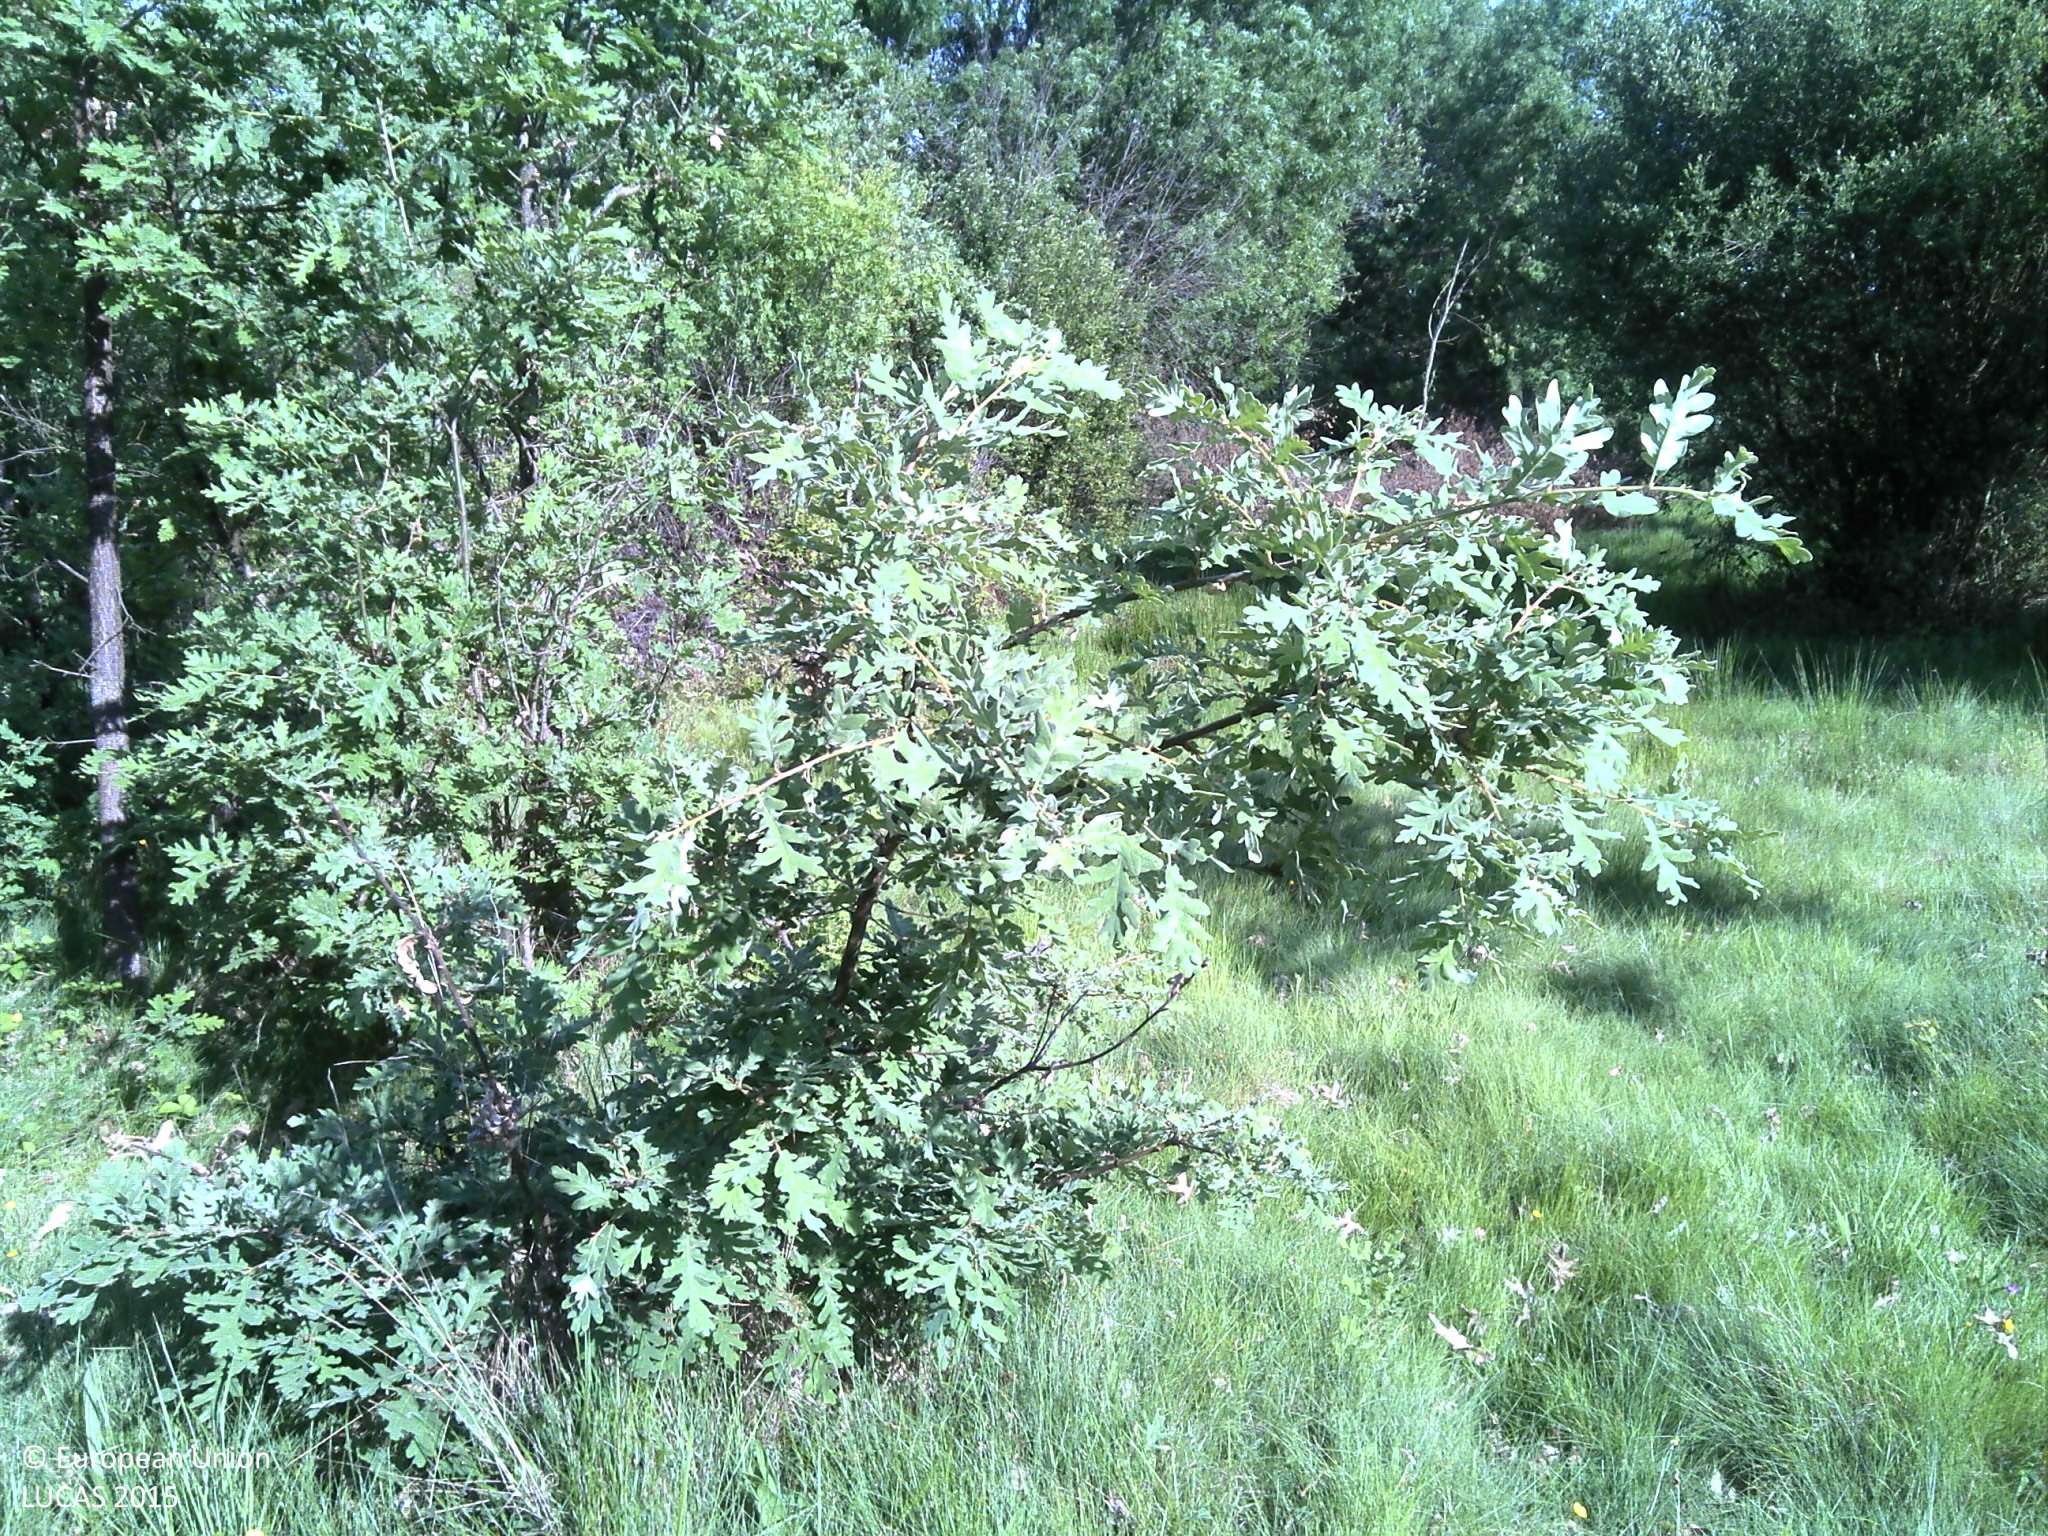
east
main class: Grassland
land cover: Grassland with sparse tree/shrub cover
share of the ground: > 75 %
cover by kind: herbaceous plants 95 %, broadleaved forest trees 5 %
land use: Agriculture (excluding fallow land and kitchen gardens)
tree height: > 5 m
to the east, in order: Grassland with sparse tree/shrub cover; Dry stone walls; Lines of trees; Grassland with sparse tree/shrub cover; Lines of trees; Dry stone walls; Grass margins; Tracks; Grass margins; Dry stone walls; Lines of trees; Grassland with sparse tree/shrub cover; Fences; Grassland without tree/shrub cover; Dry stone walls; Shrubland with sparse tree cover; Grassland without tree/shrub cover; Lines of trees; Dry stone walls; Grassland without tree/shrub cover; Lines of trees; Grassland without tree/shrub cover
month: May
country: PT
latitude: 41.6794
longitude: -7.3400
